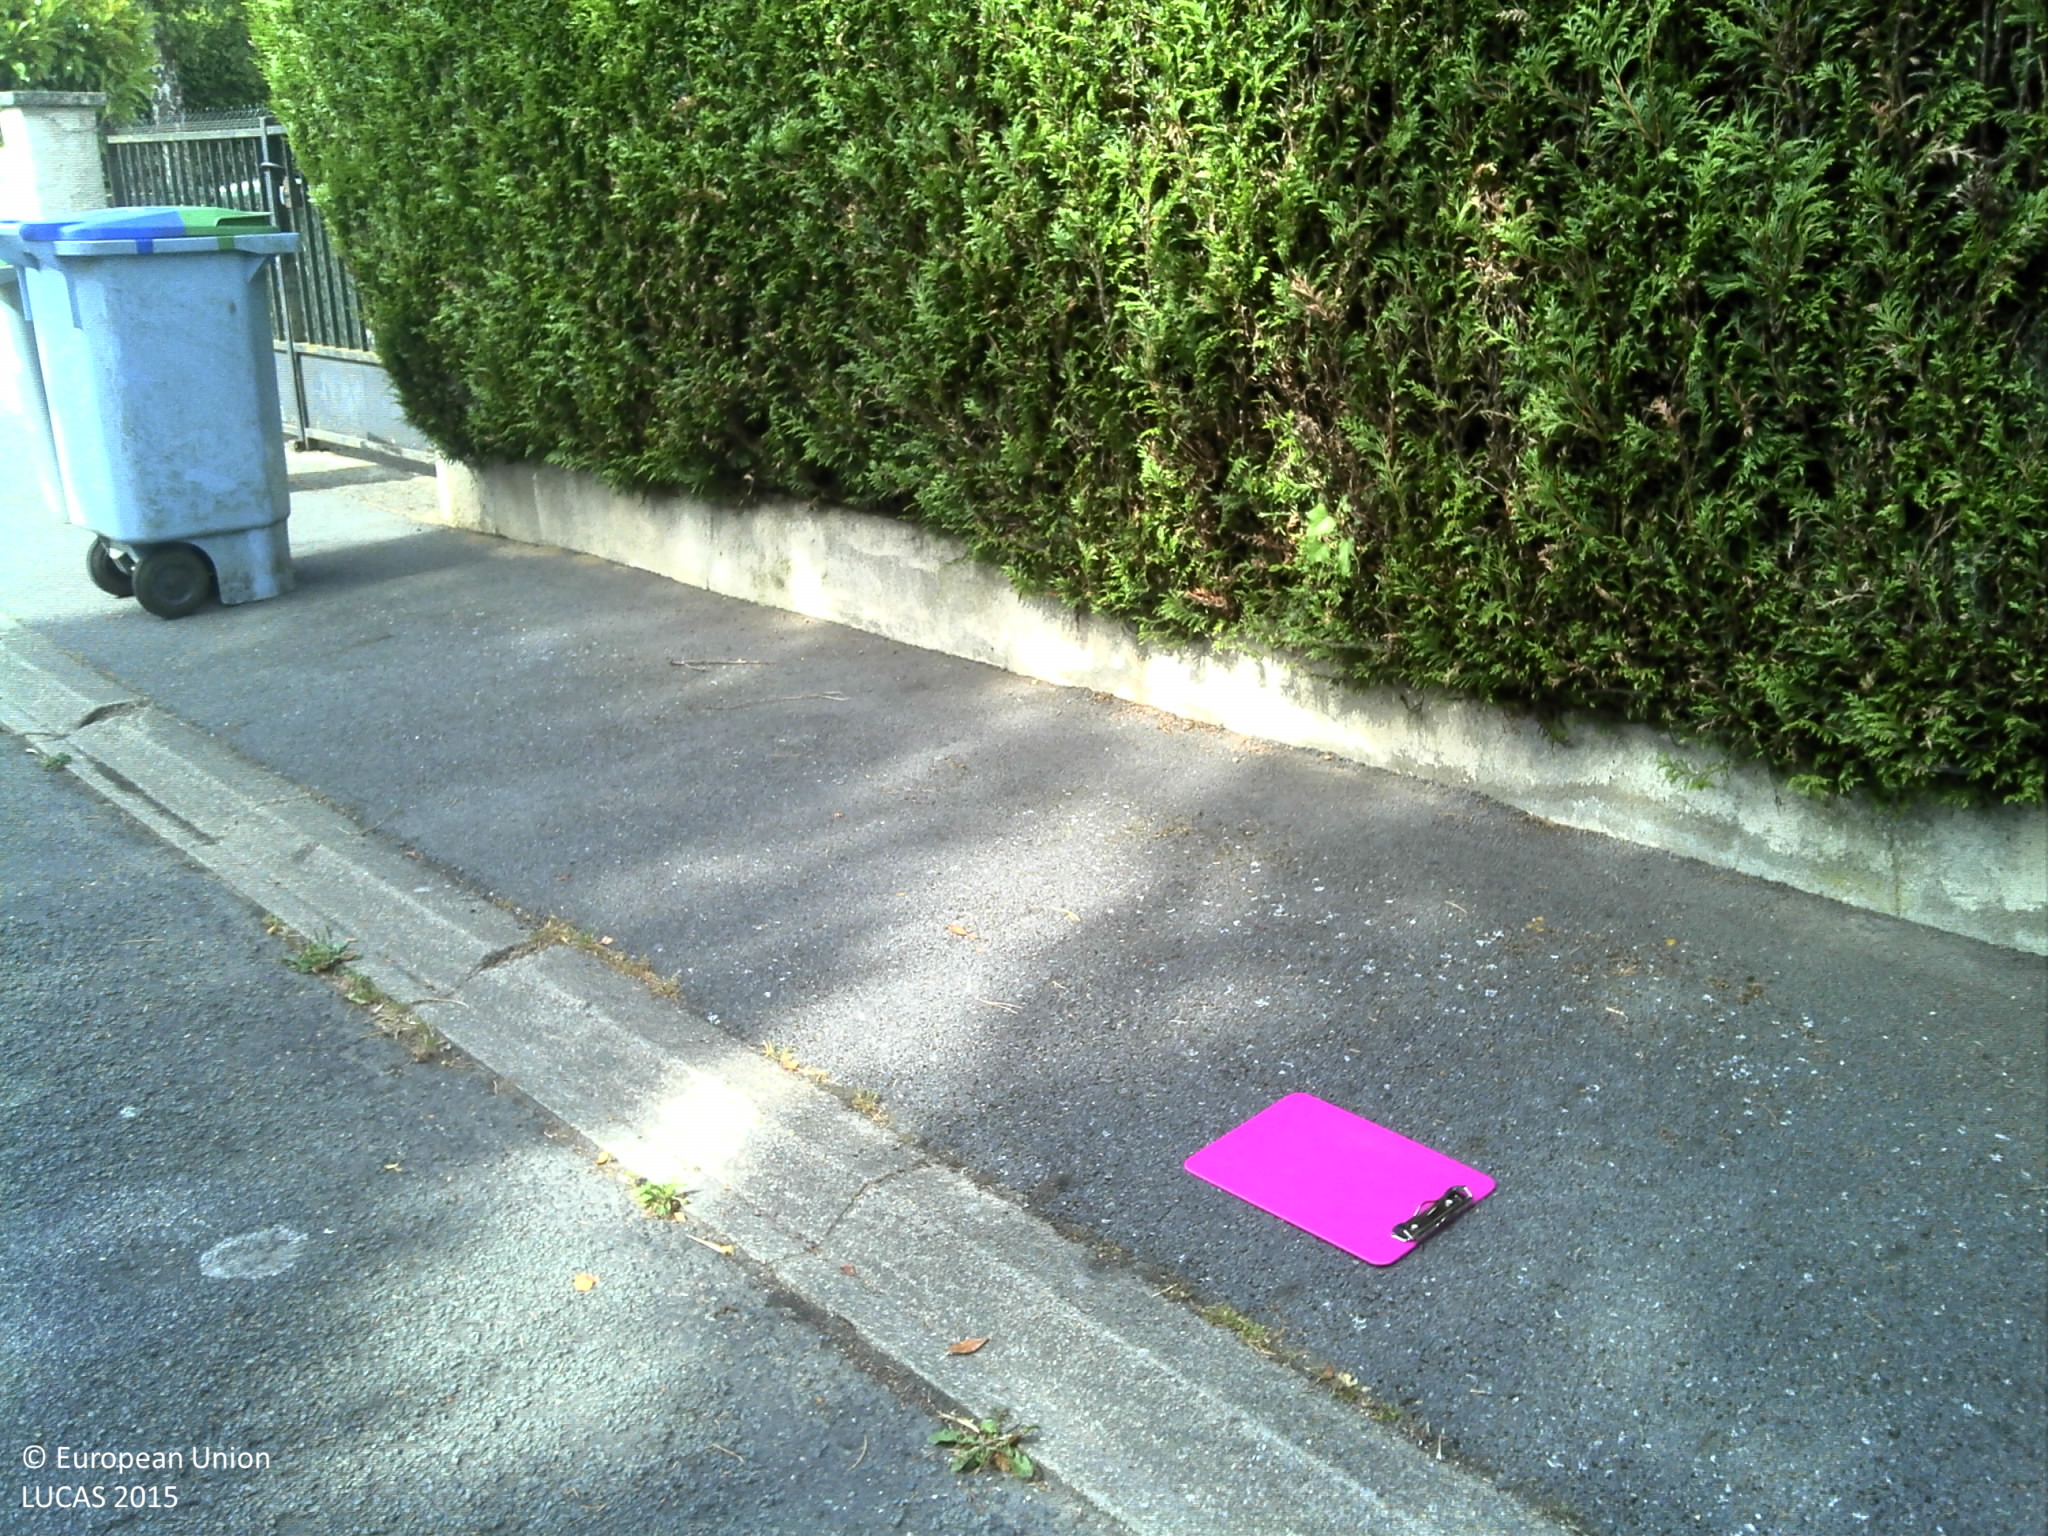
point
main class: Grassland
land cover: Grassland with sparse tree/shrub cover
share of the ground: > 75 %
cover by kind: herbaceous plants 95 %, broadleaved forest trees 5 %
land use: Residential
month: July
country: FR
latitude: 48.5796
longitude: 1.9479
